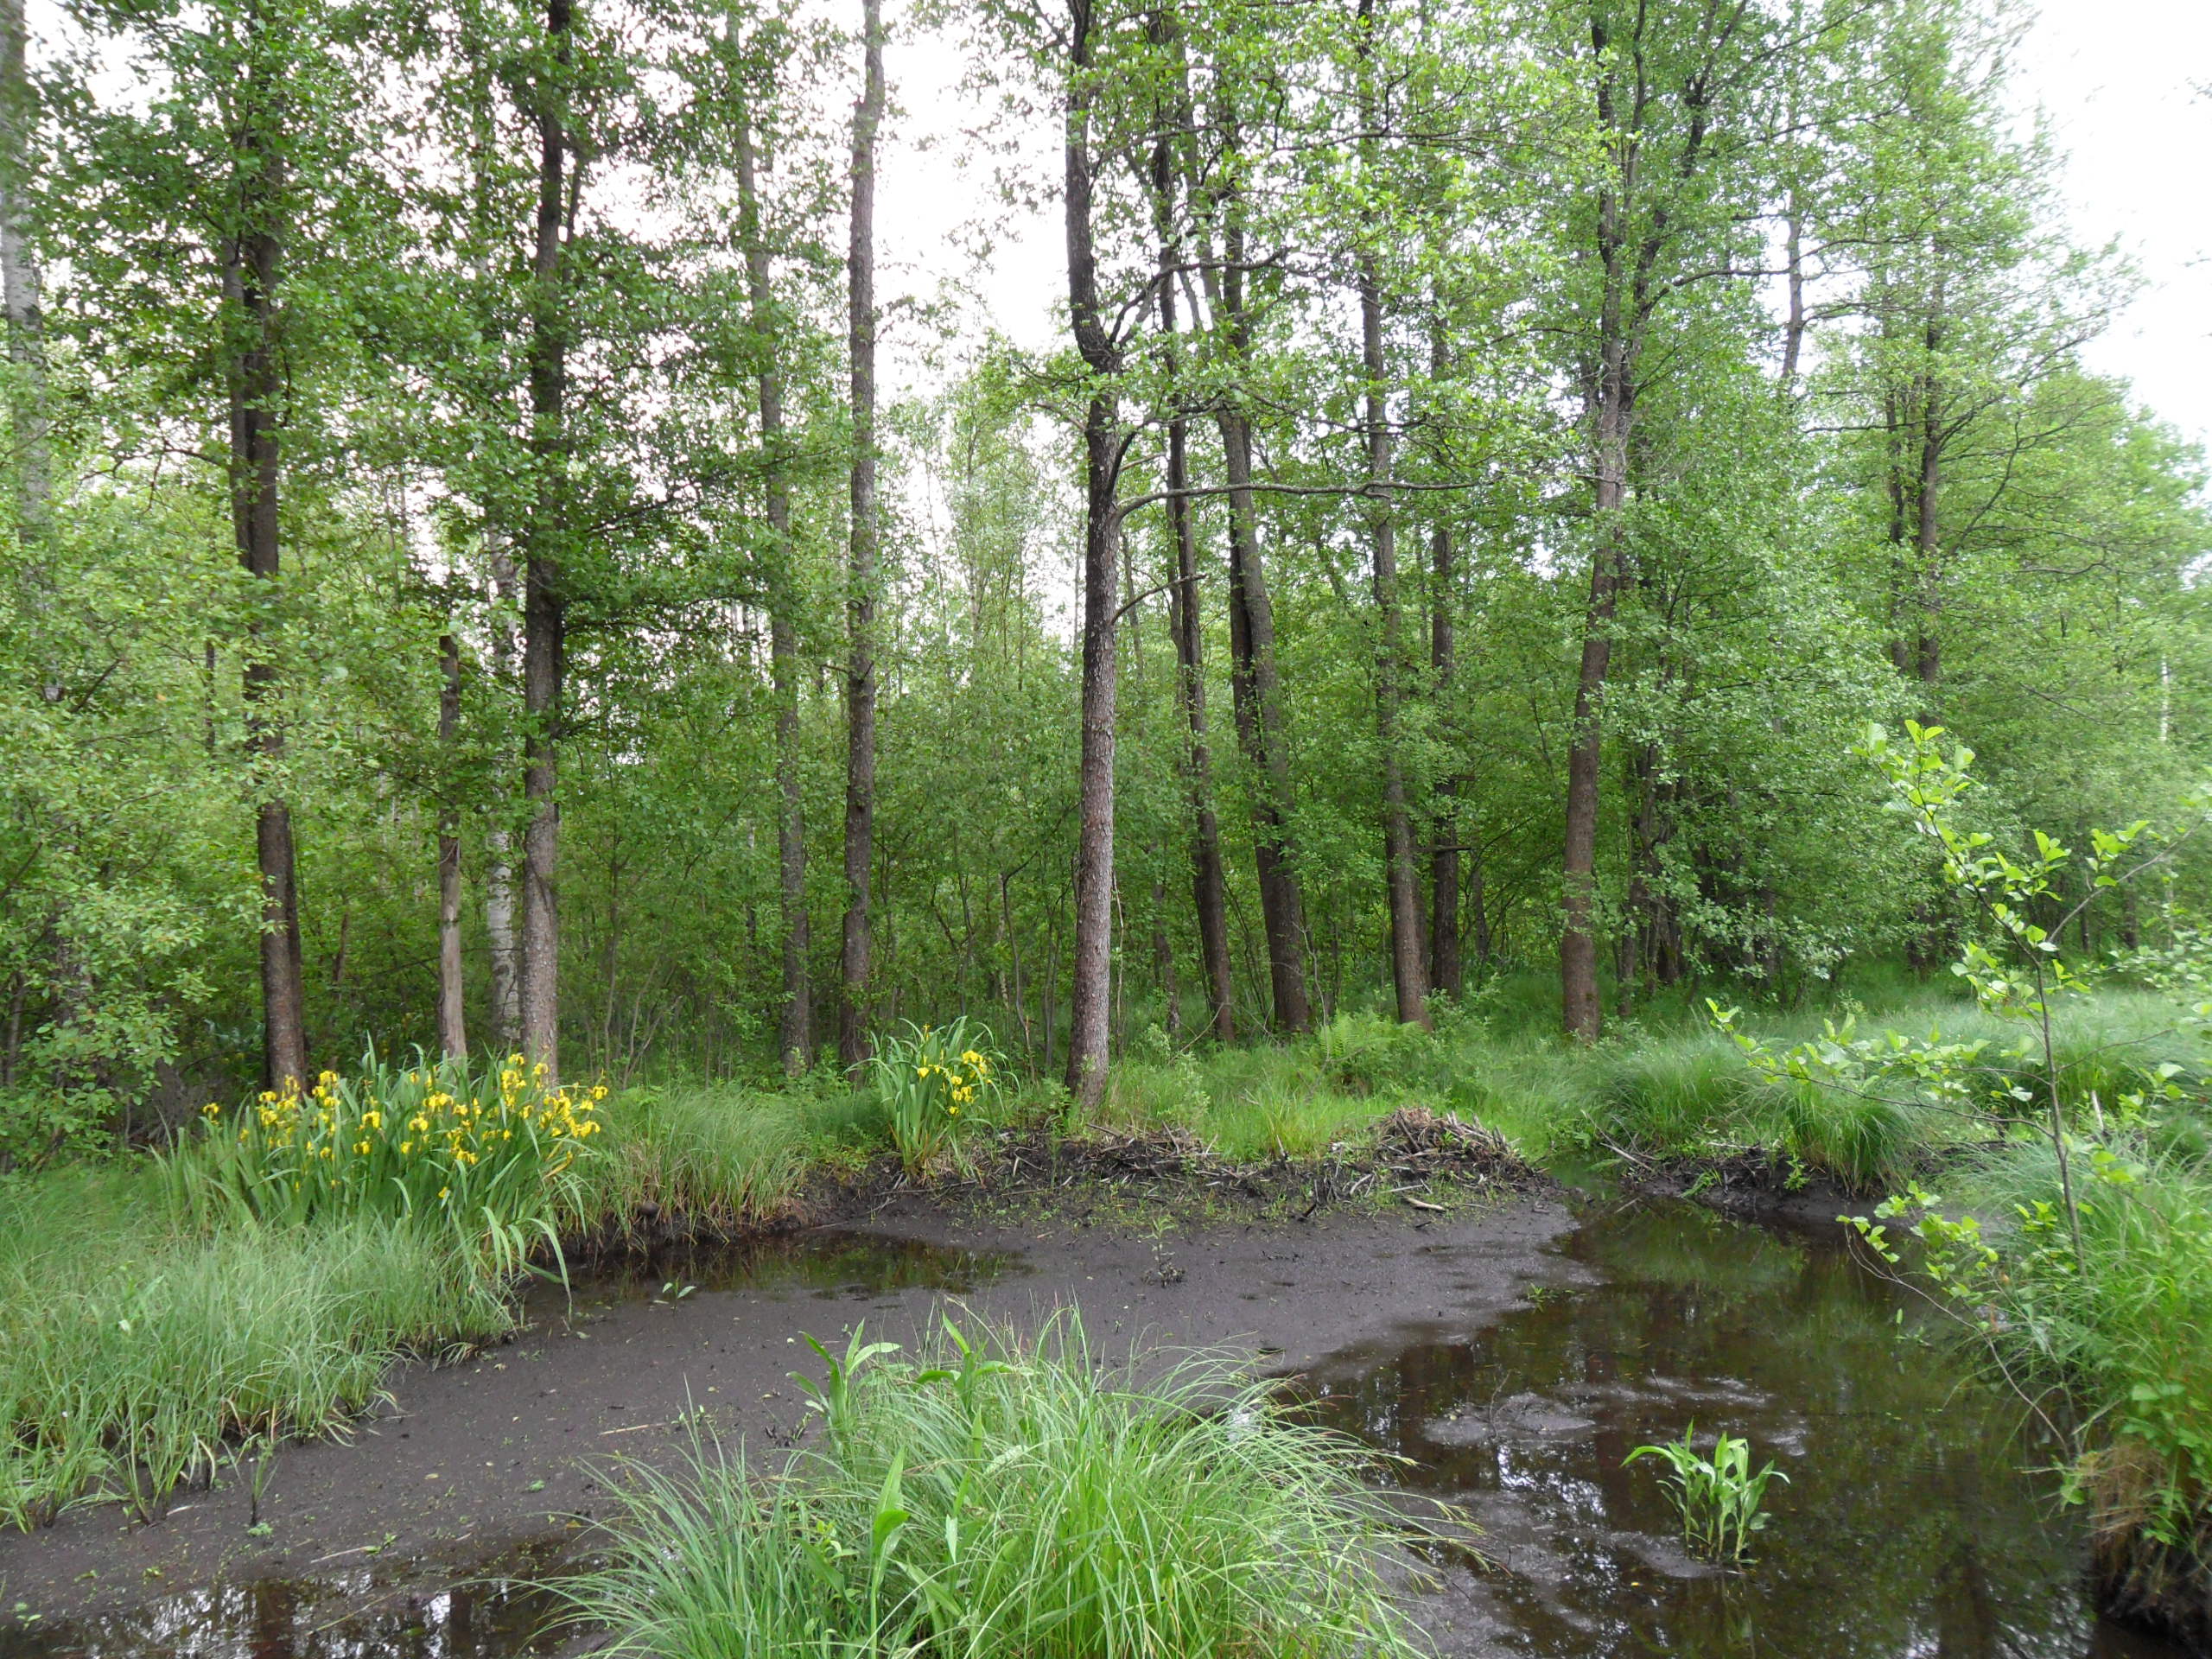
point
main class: Woodland
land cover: Broadleaved woodland
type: mire and swamp forests
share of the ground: 50 - 75 %
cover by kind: broadleaved forest trees 70 %, herbaceous plants 10 %
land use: Semi-natural and natural areas not in use
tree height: > 5 m
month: June
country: LV
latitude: 57.2132
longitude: 22.1186
